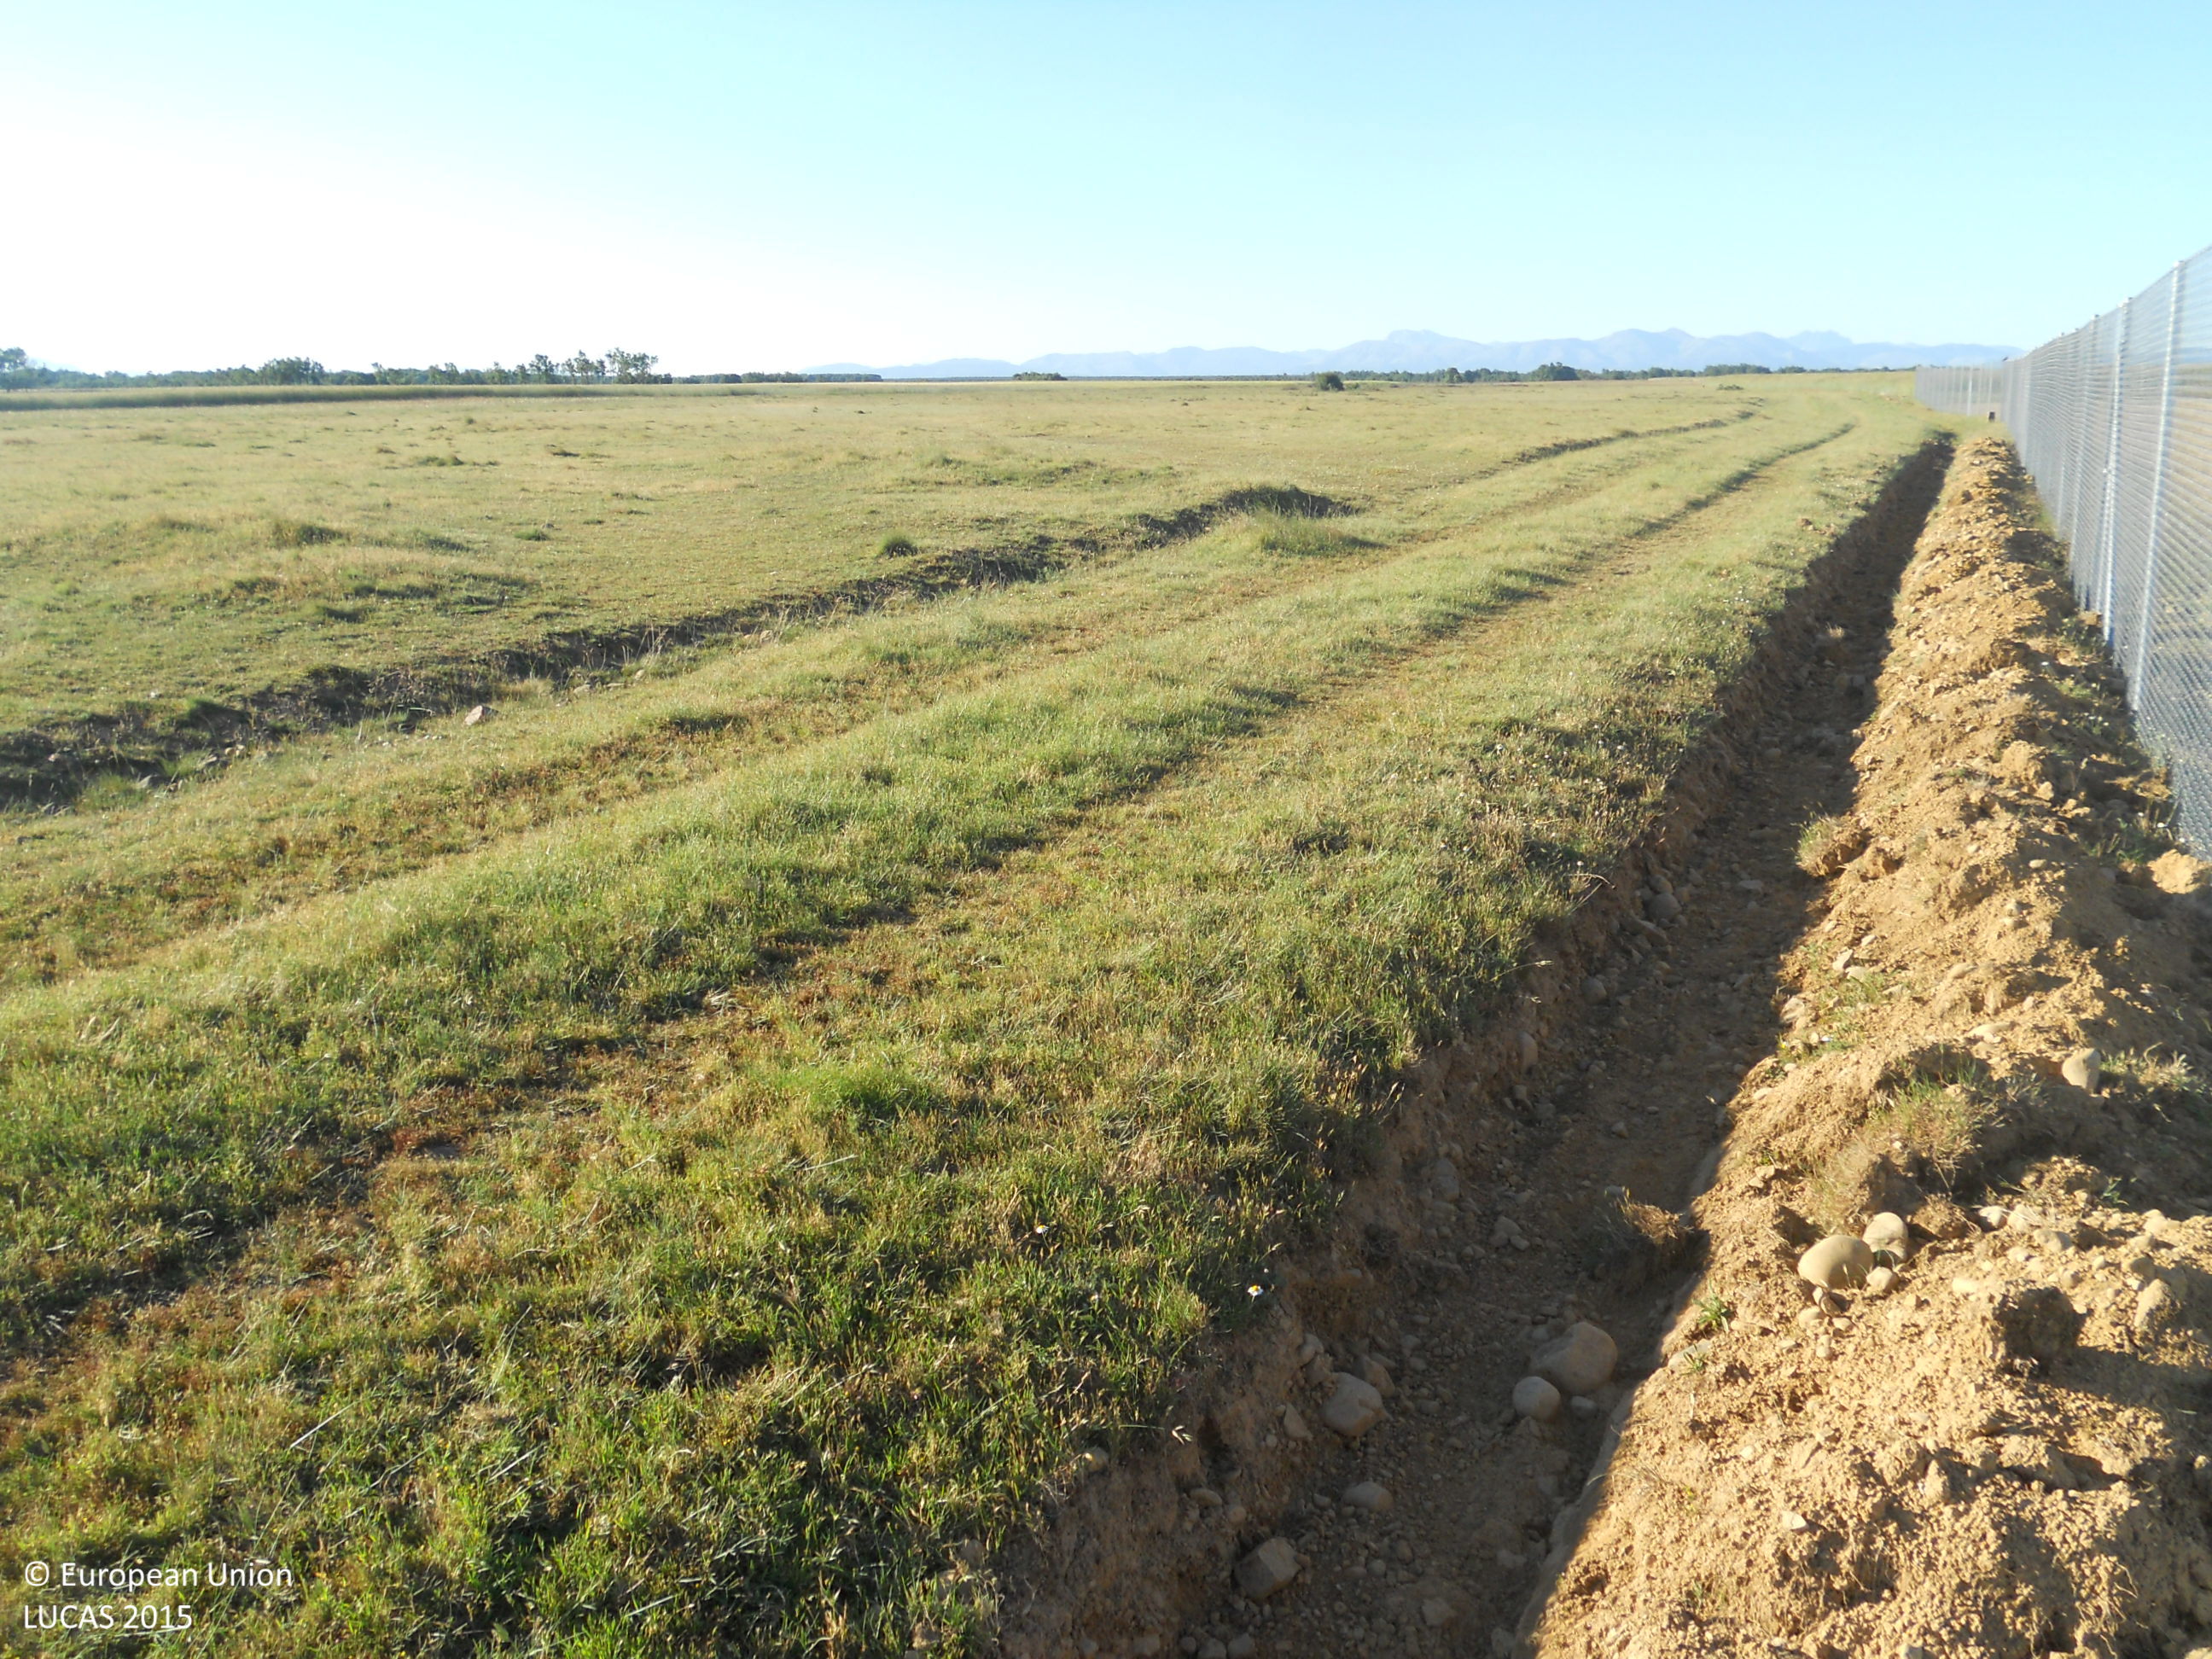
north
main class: Grassland
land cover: Spontaneously vegetated surfaces
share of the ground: > 75 %
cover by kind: herbaceous plants 100 %
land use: Fallow land
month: June
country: ES
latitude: 42.5594
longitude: -4.8570
